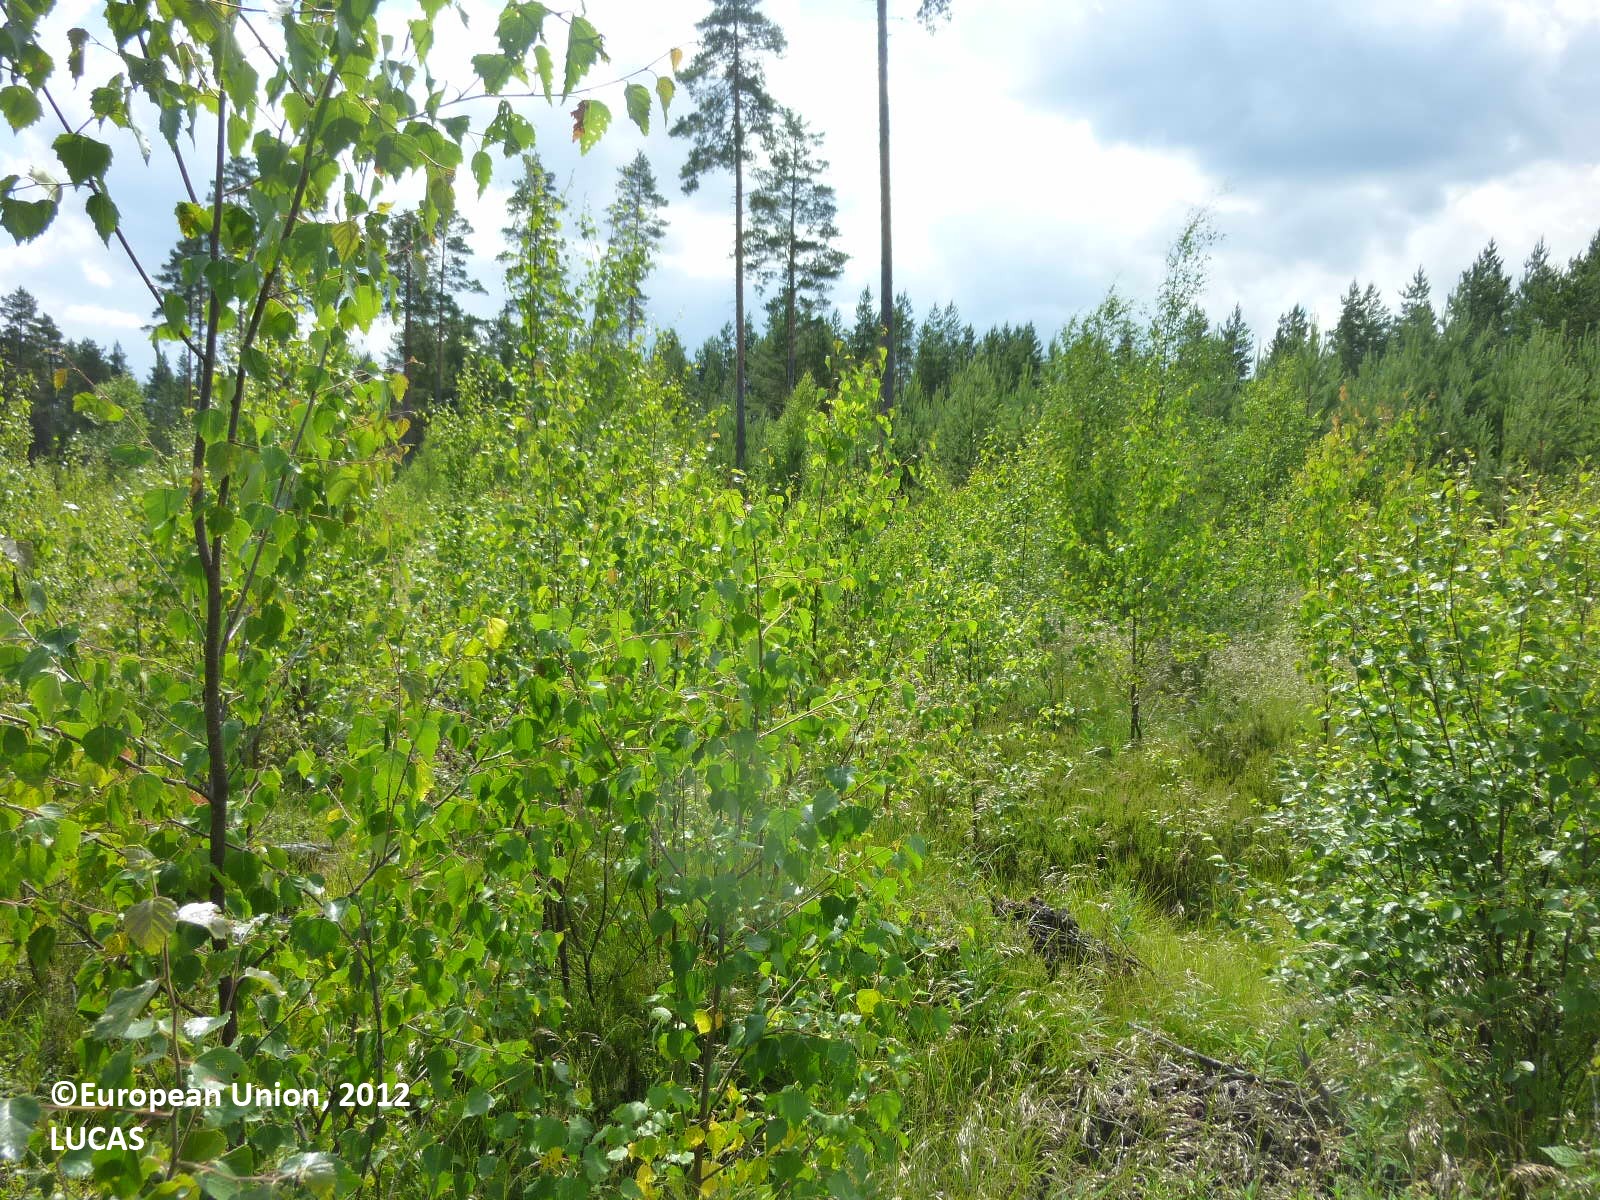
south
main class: Woodland
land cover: Other mixed woodland
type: boreal forest
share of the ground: 50 - 75 %
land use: Forestry
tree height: < 5 m
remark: Clear cut
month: July
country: FI
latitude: 61.2046
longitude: 22.3652
